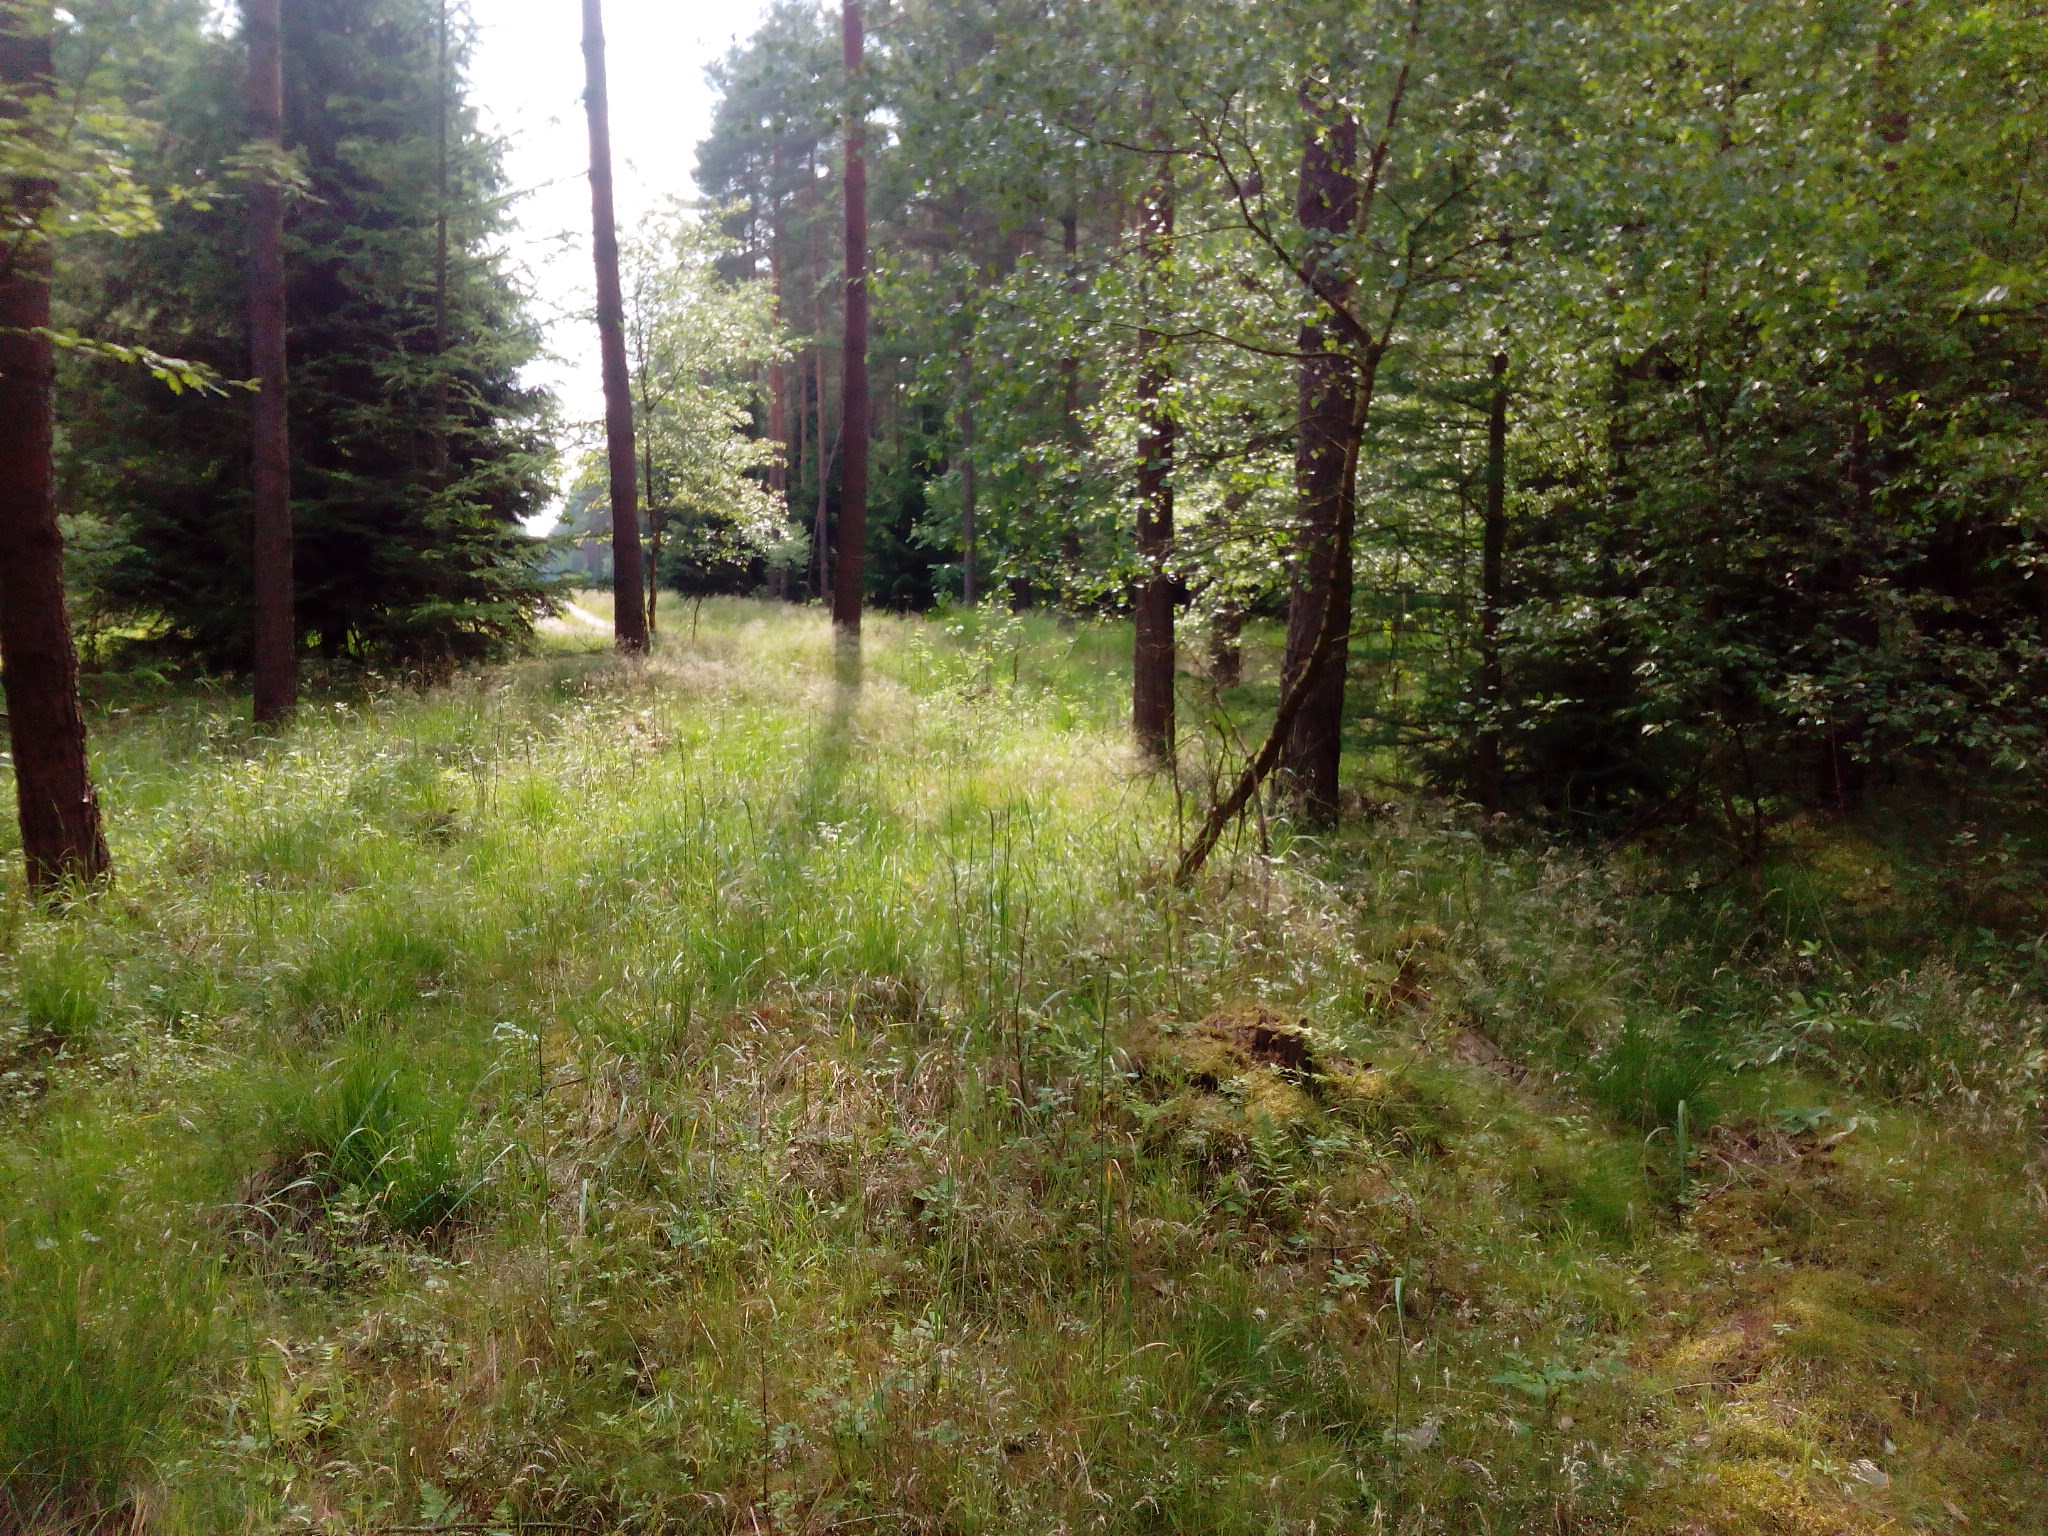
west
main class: Woodland
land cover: Pine dominated coniferous woodland
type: hemiboreal forest and nemoral coniferous forest and mixed broadleaved-coniferous forest
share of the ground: > 75 %
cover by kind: coniferous forest trees 75 %, herbaceous plants 15 %, broadleaved forest trees 5 %, shrubs 5 %
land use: Forestry
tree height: > 5 m
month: June
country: DE
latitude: 52.6290
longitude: 9.8966
